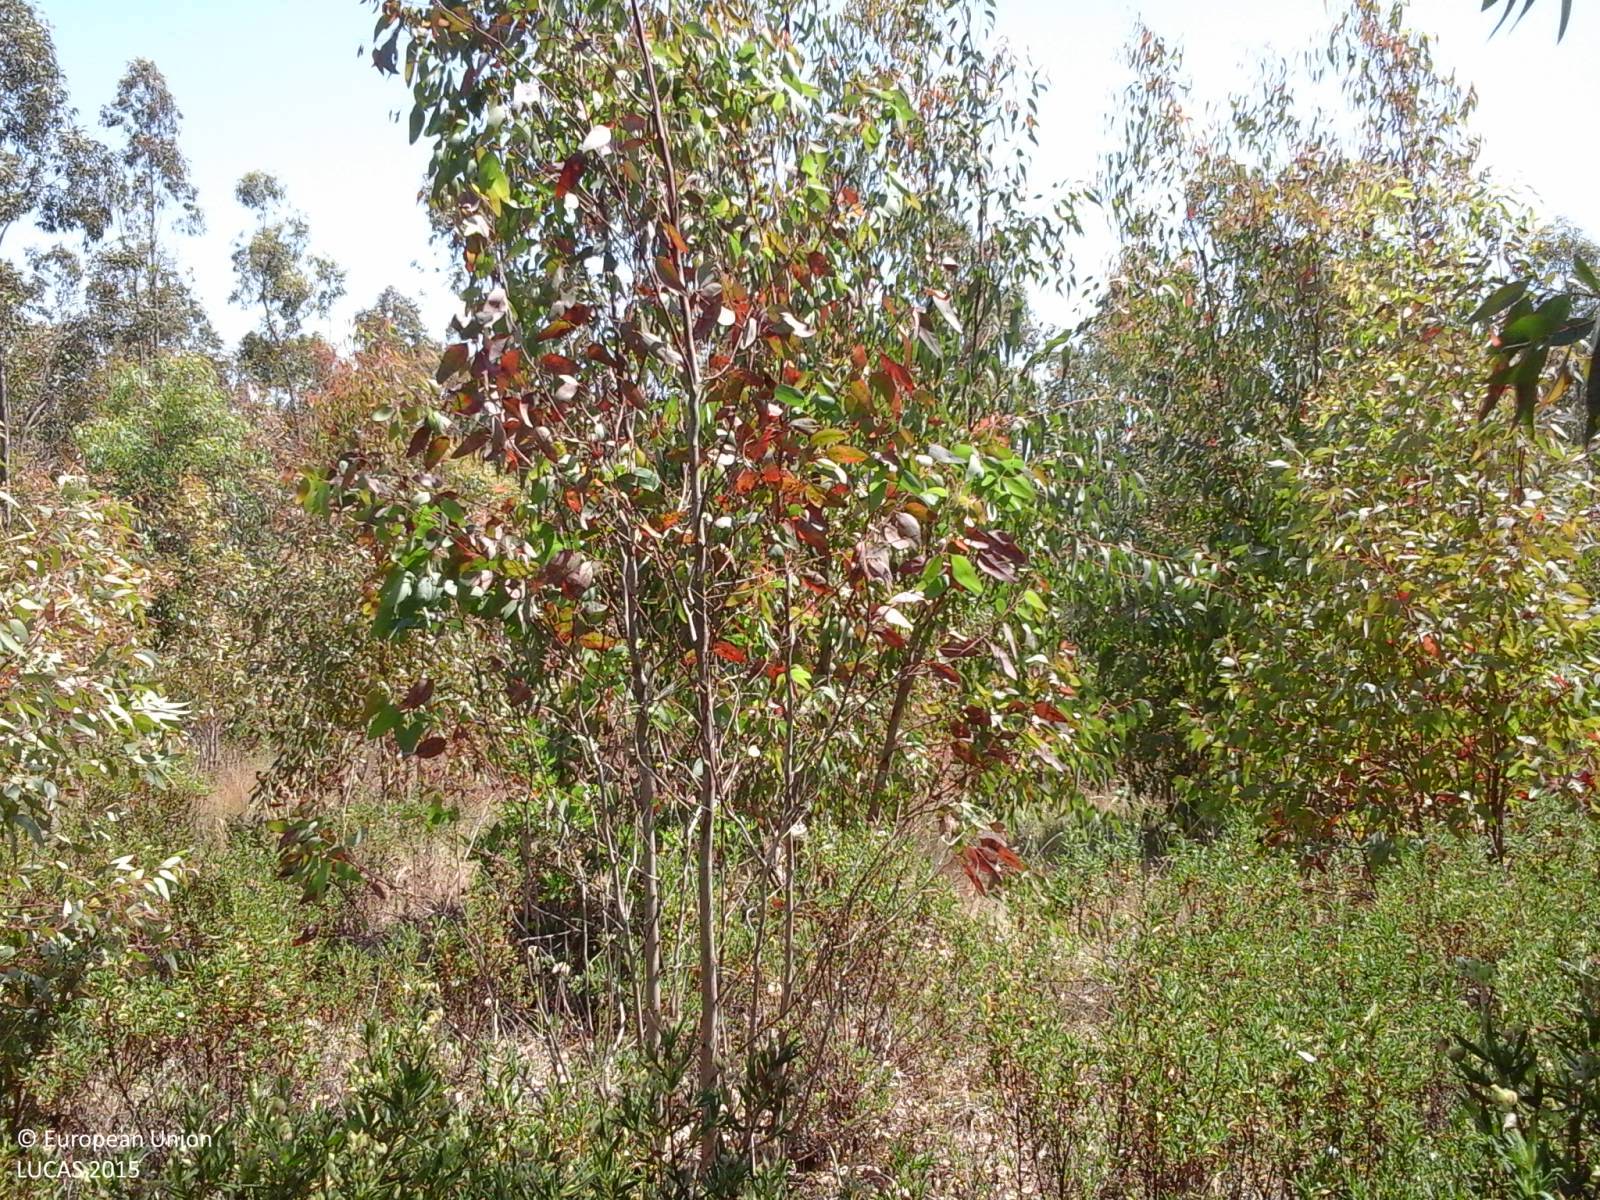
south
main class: Woodland
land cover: Broadleaved woodland
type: exotic forest
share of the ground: > 75 %
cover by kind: broadleaved forest trees 100 %
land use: Forestry
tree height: < 5 m
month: May
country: IT
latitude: 39.7871
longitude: 8.6415
